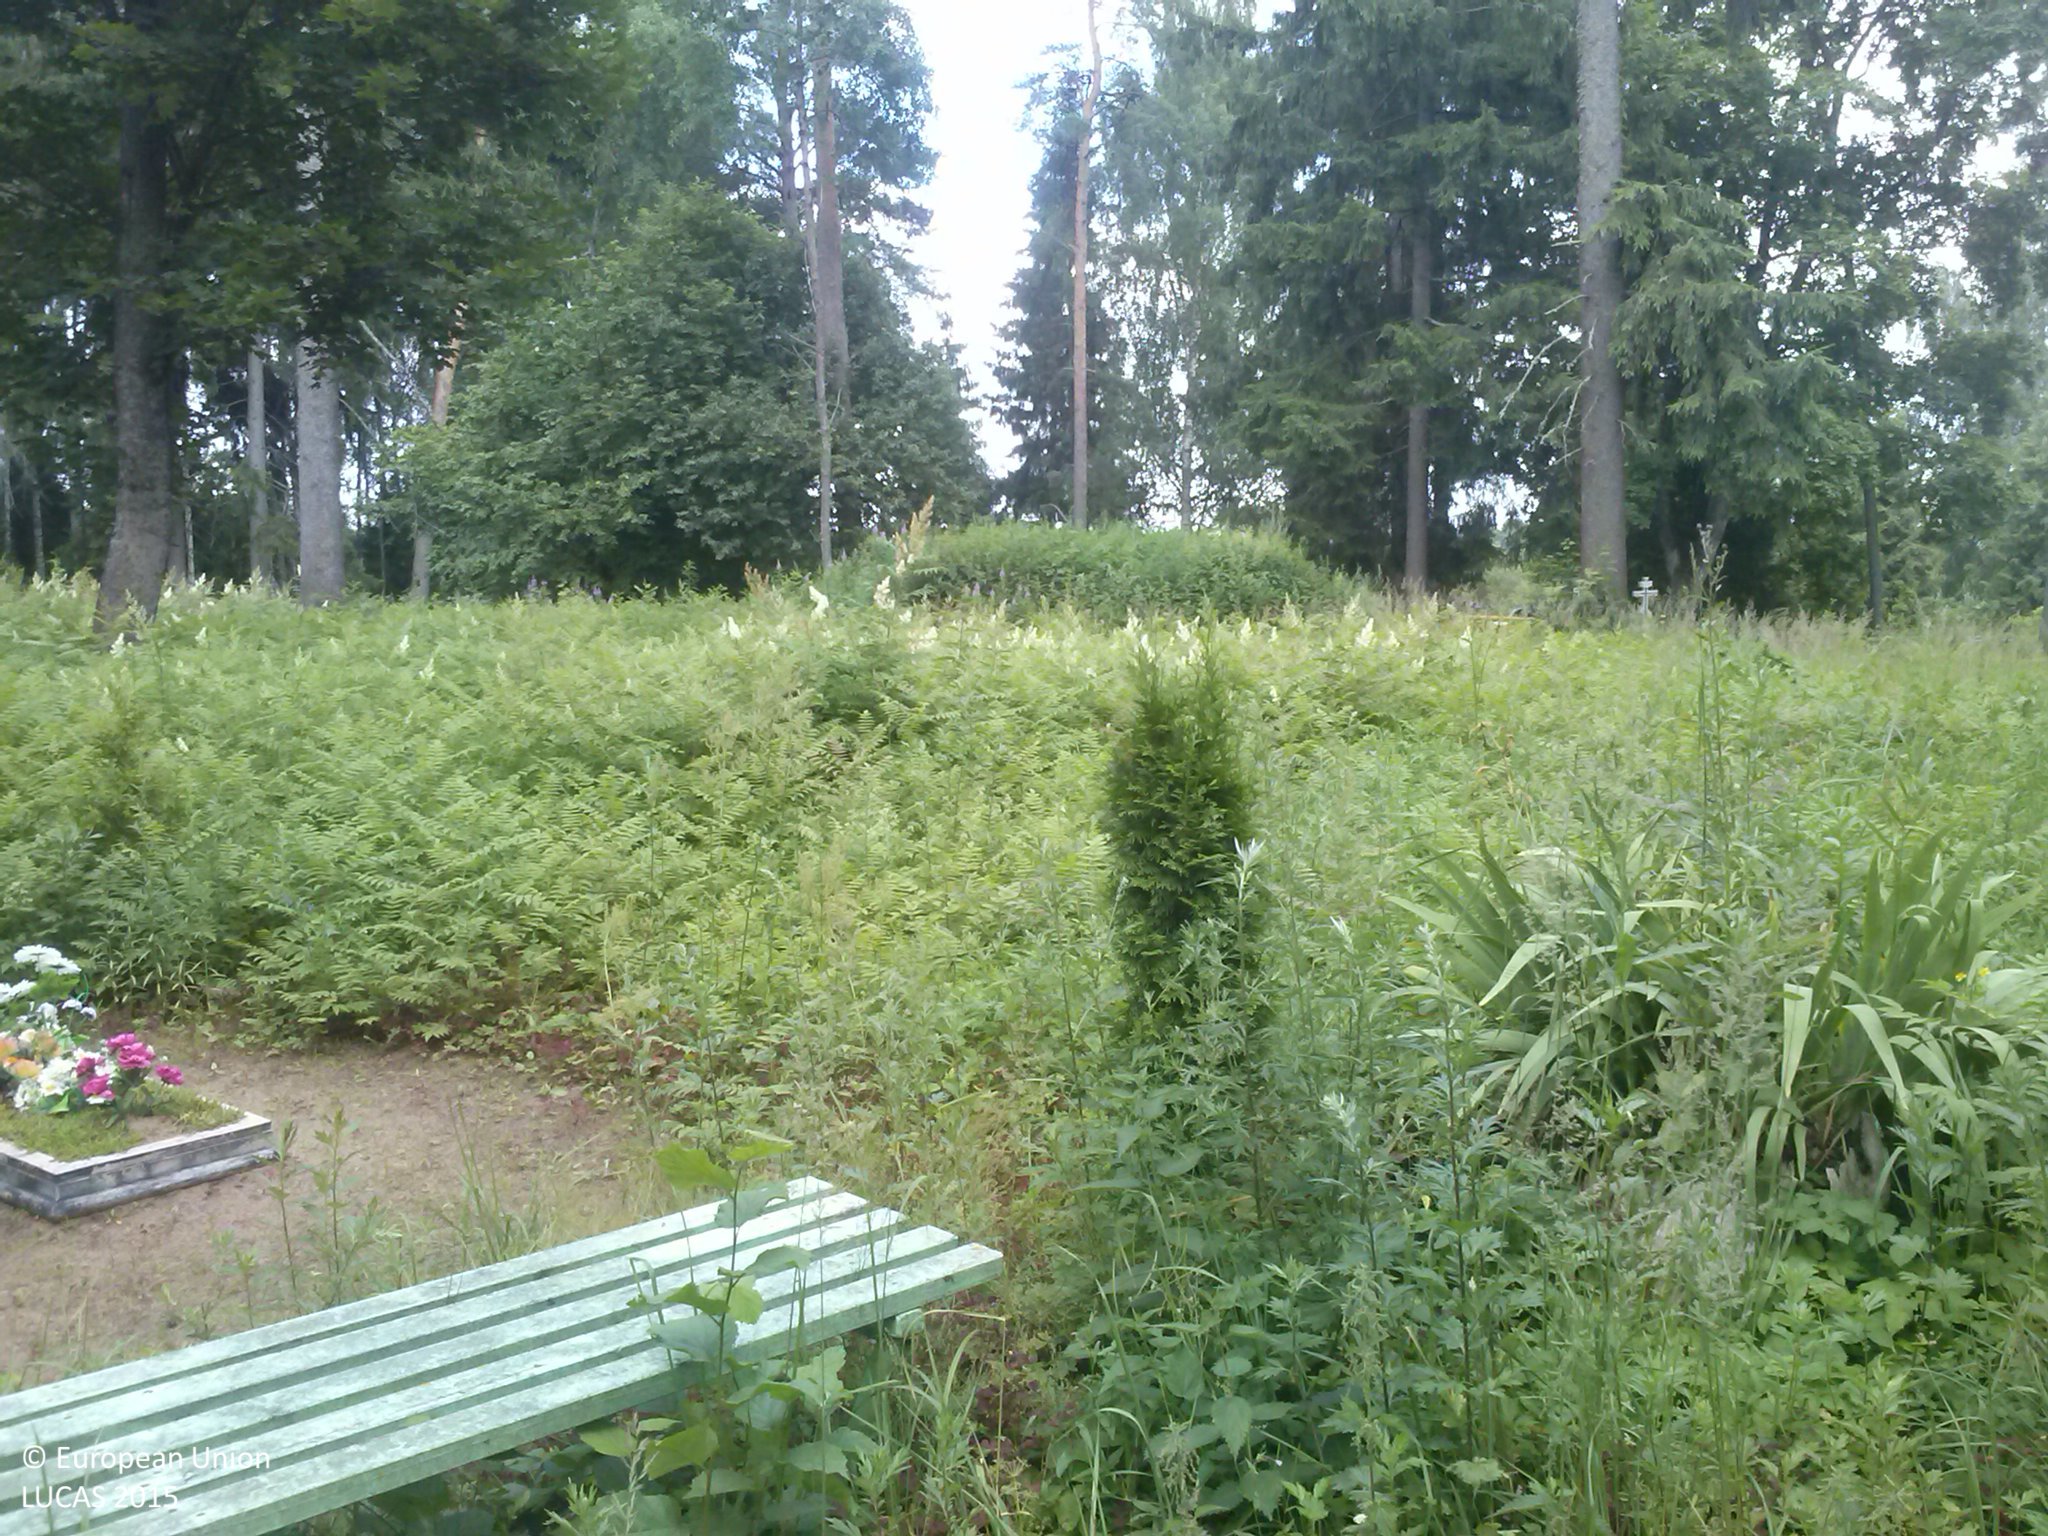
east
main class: Grassland
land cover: Grassland without tree/shrub cover
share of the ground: > 75 %
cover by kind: herbaceous plants 100 %
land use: Community services
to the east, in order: Grassland without tree/shrub cover; Spruce dominated mixed woodland; Fences; Grassland with sparse tree/shrub cover; Paved roads, cycling and walking lanes; Spontaneously vegetated surfaces
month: July
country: LV
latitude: 56.5477
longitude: 27.0314
